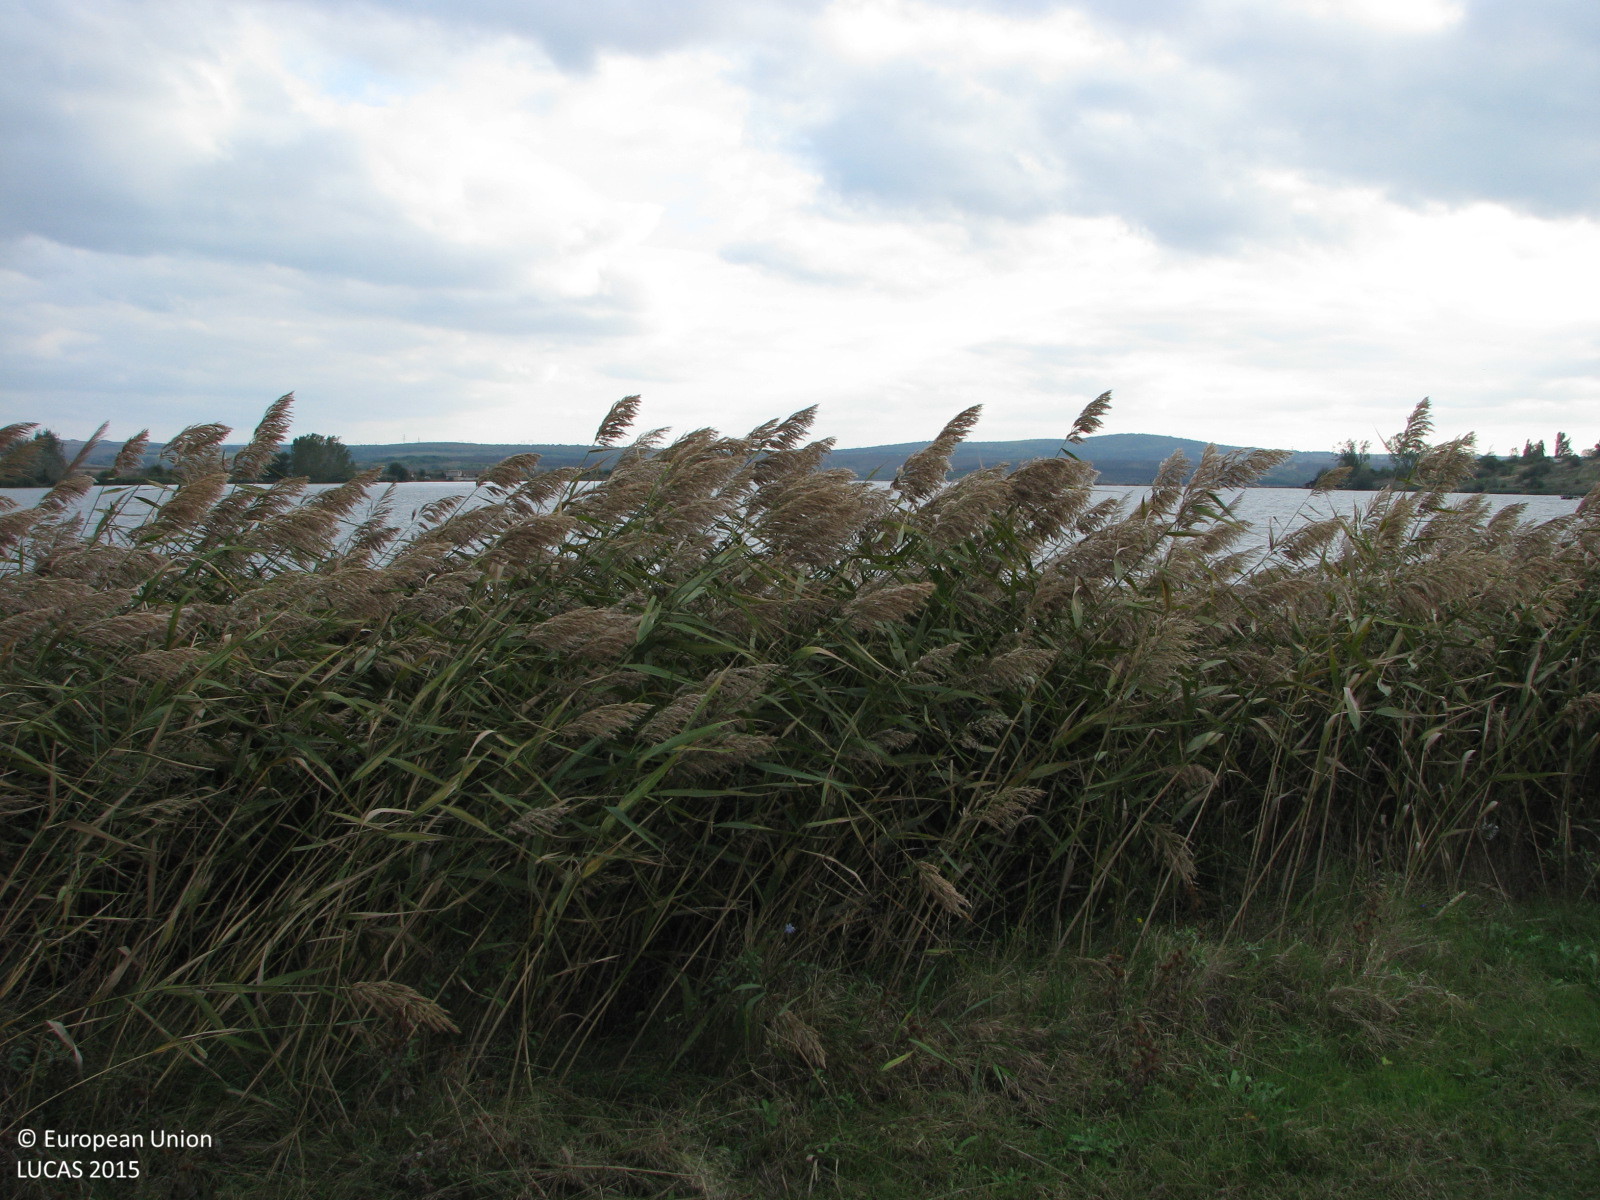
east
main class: Cropland
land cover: Sunflower
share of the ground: 50 - 75 %
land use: Agriculture (excluding fallow land and kitchen gardens)
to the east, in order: Sunflower; Grass margins; Tracks; Grassland without tree/shrub cover; Tracks; Grassland without tree/shrub cover; Inland fresh water bodies
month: October
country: BG
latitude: 42.2678
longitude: 26.1451
